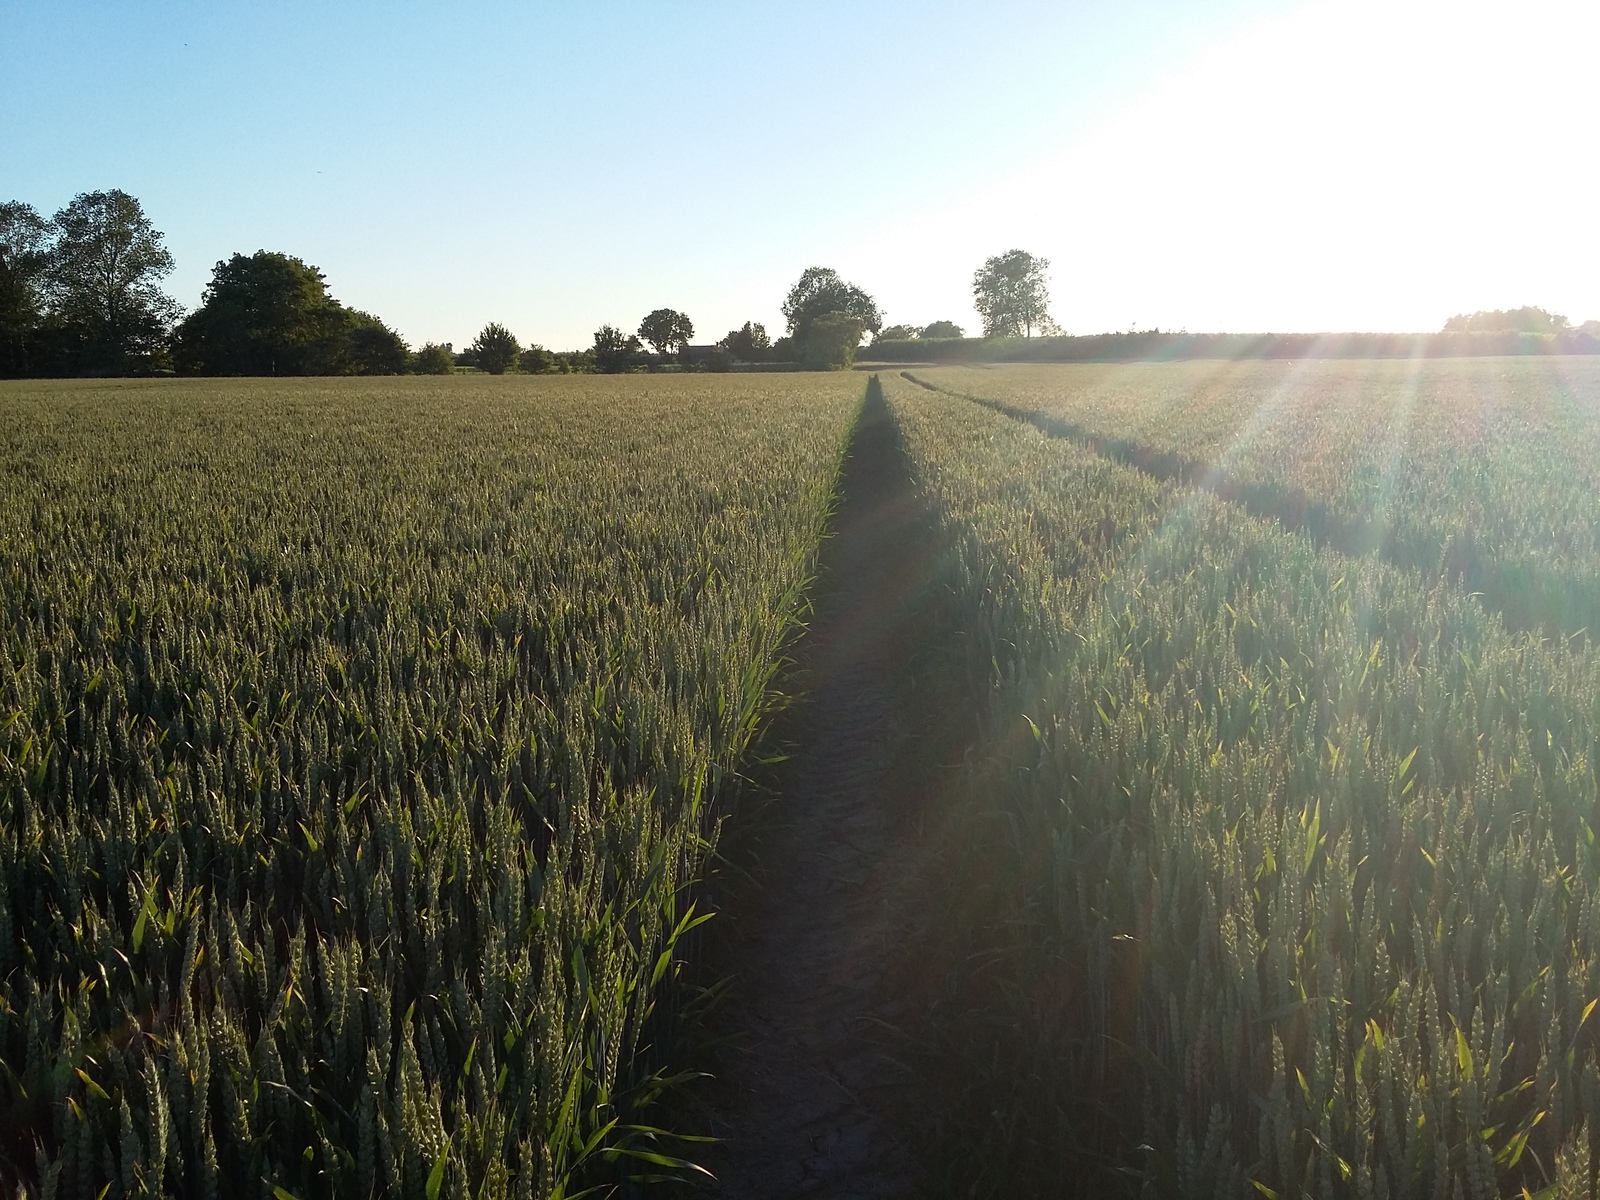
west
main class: Cropland
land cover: Common wheat
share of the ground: > 75 %
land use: Agriculture (excluding fallow land and kitchen gardens)
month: July
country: DK
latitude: 55.0910
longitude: 12.1451
